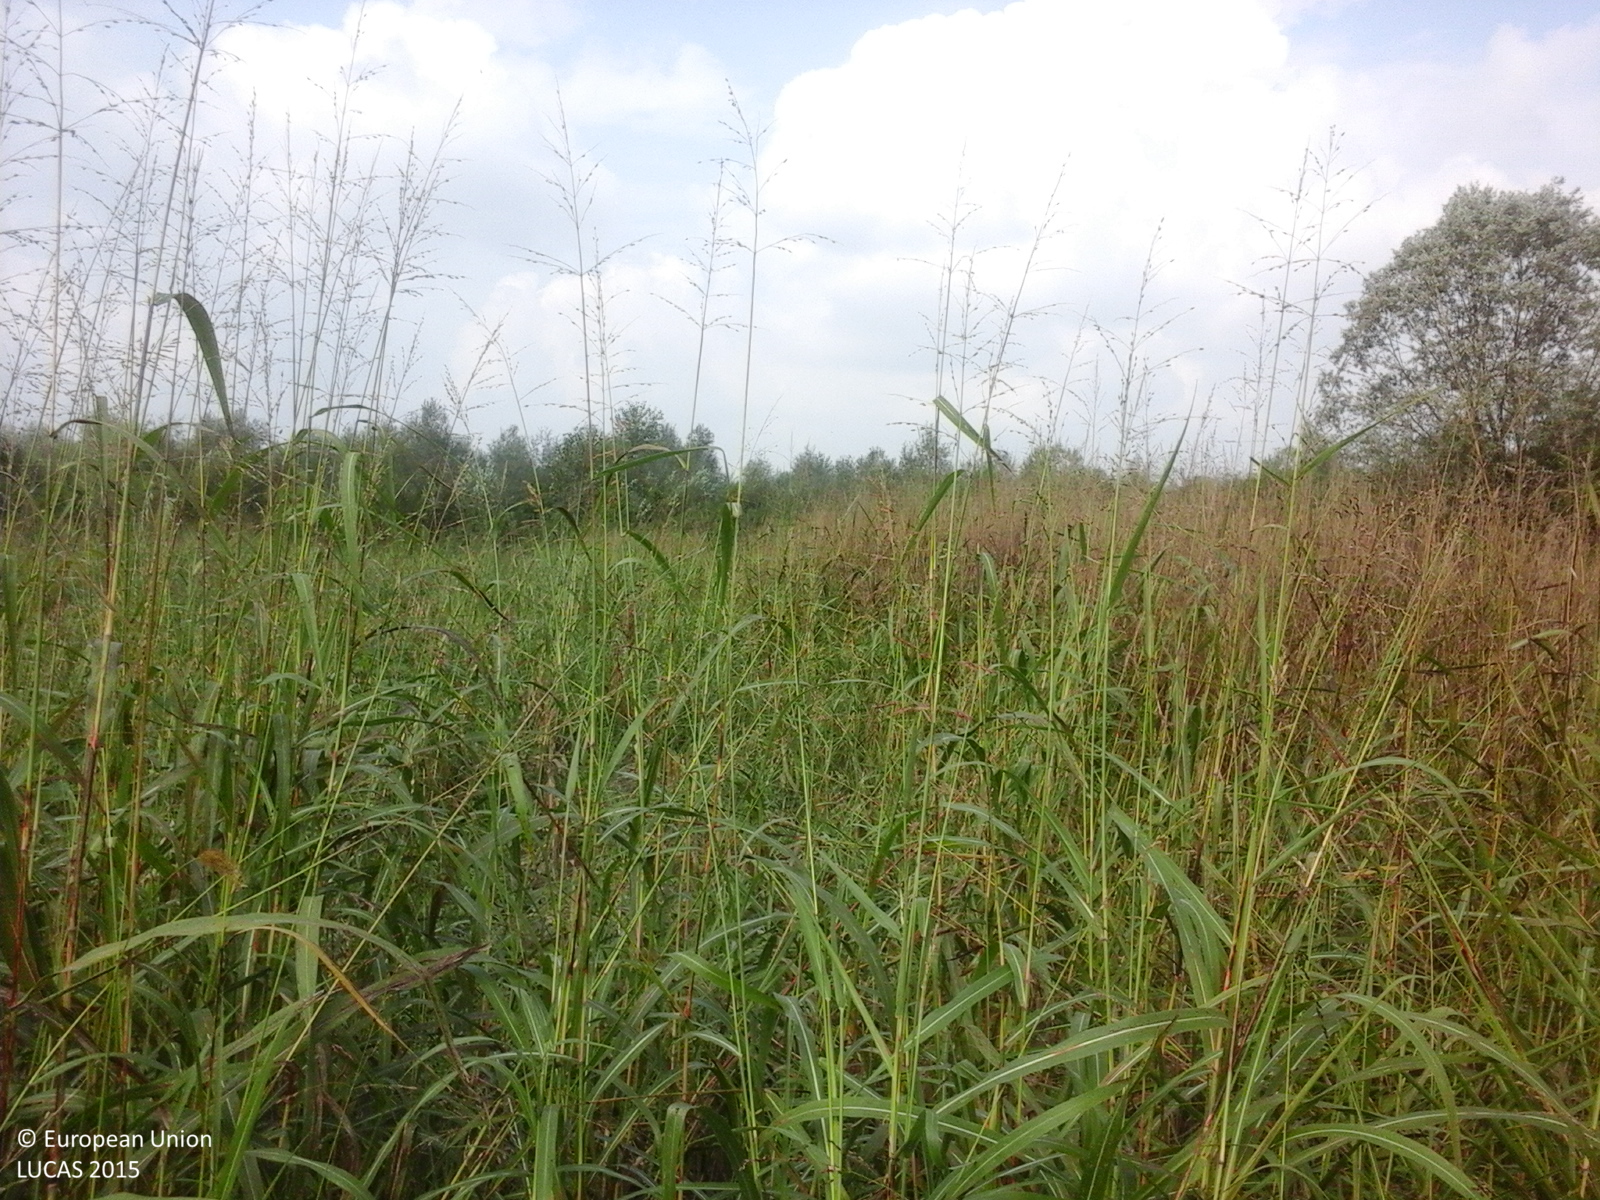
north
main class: Grassland
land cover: Spontaneously vegetated surfaces
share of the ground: > 75 %
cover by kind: herbaceous plants 100 %
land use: Fallow land
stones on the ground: < 10 %
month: September
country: RO
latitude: 44.9635
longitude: 23.1990
